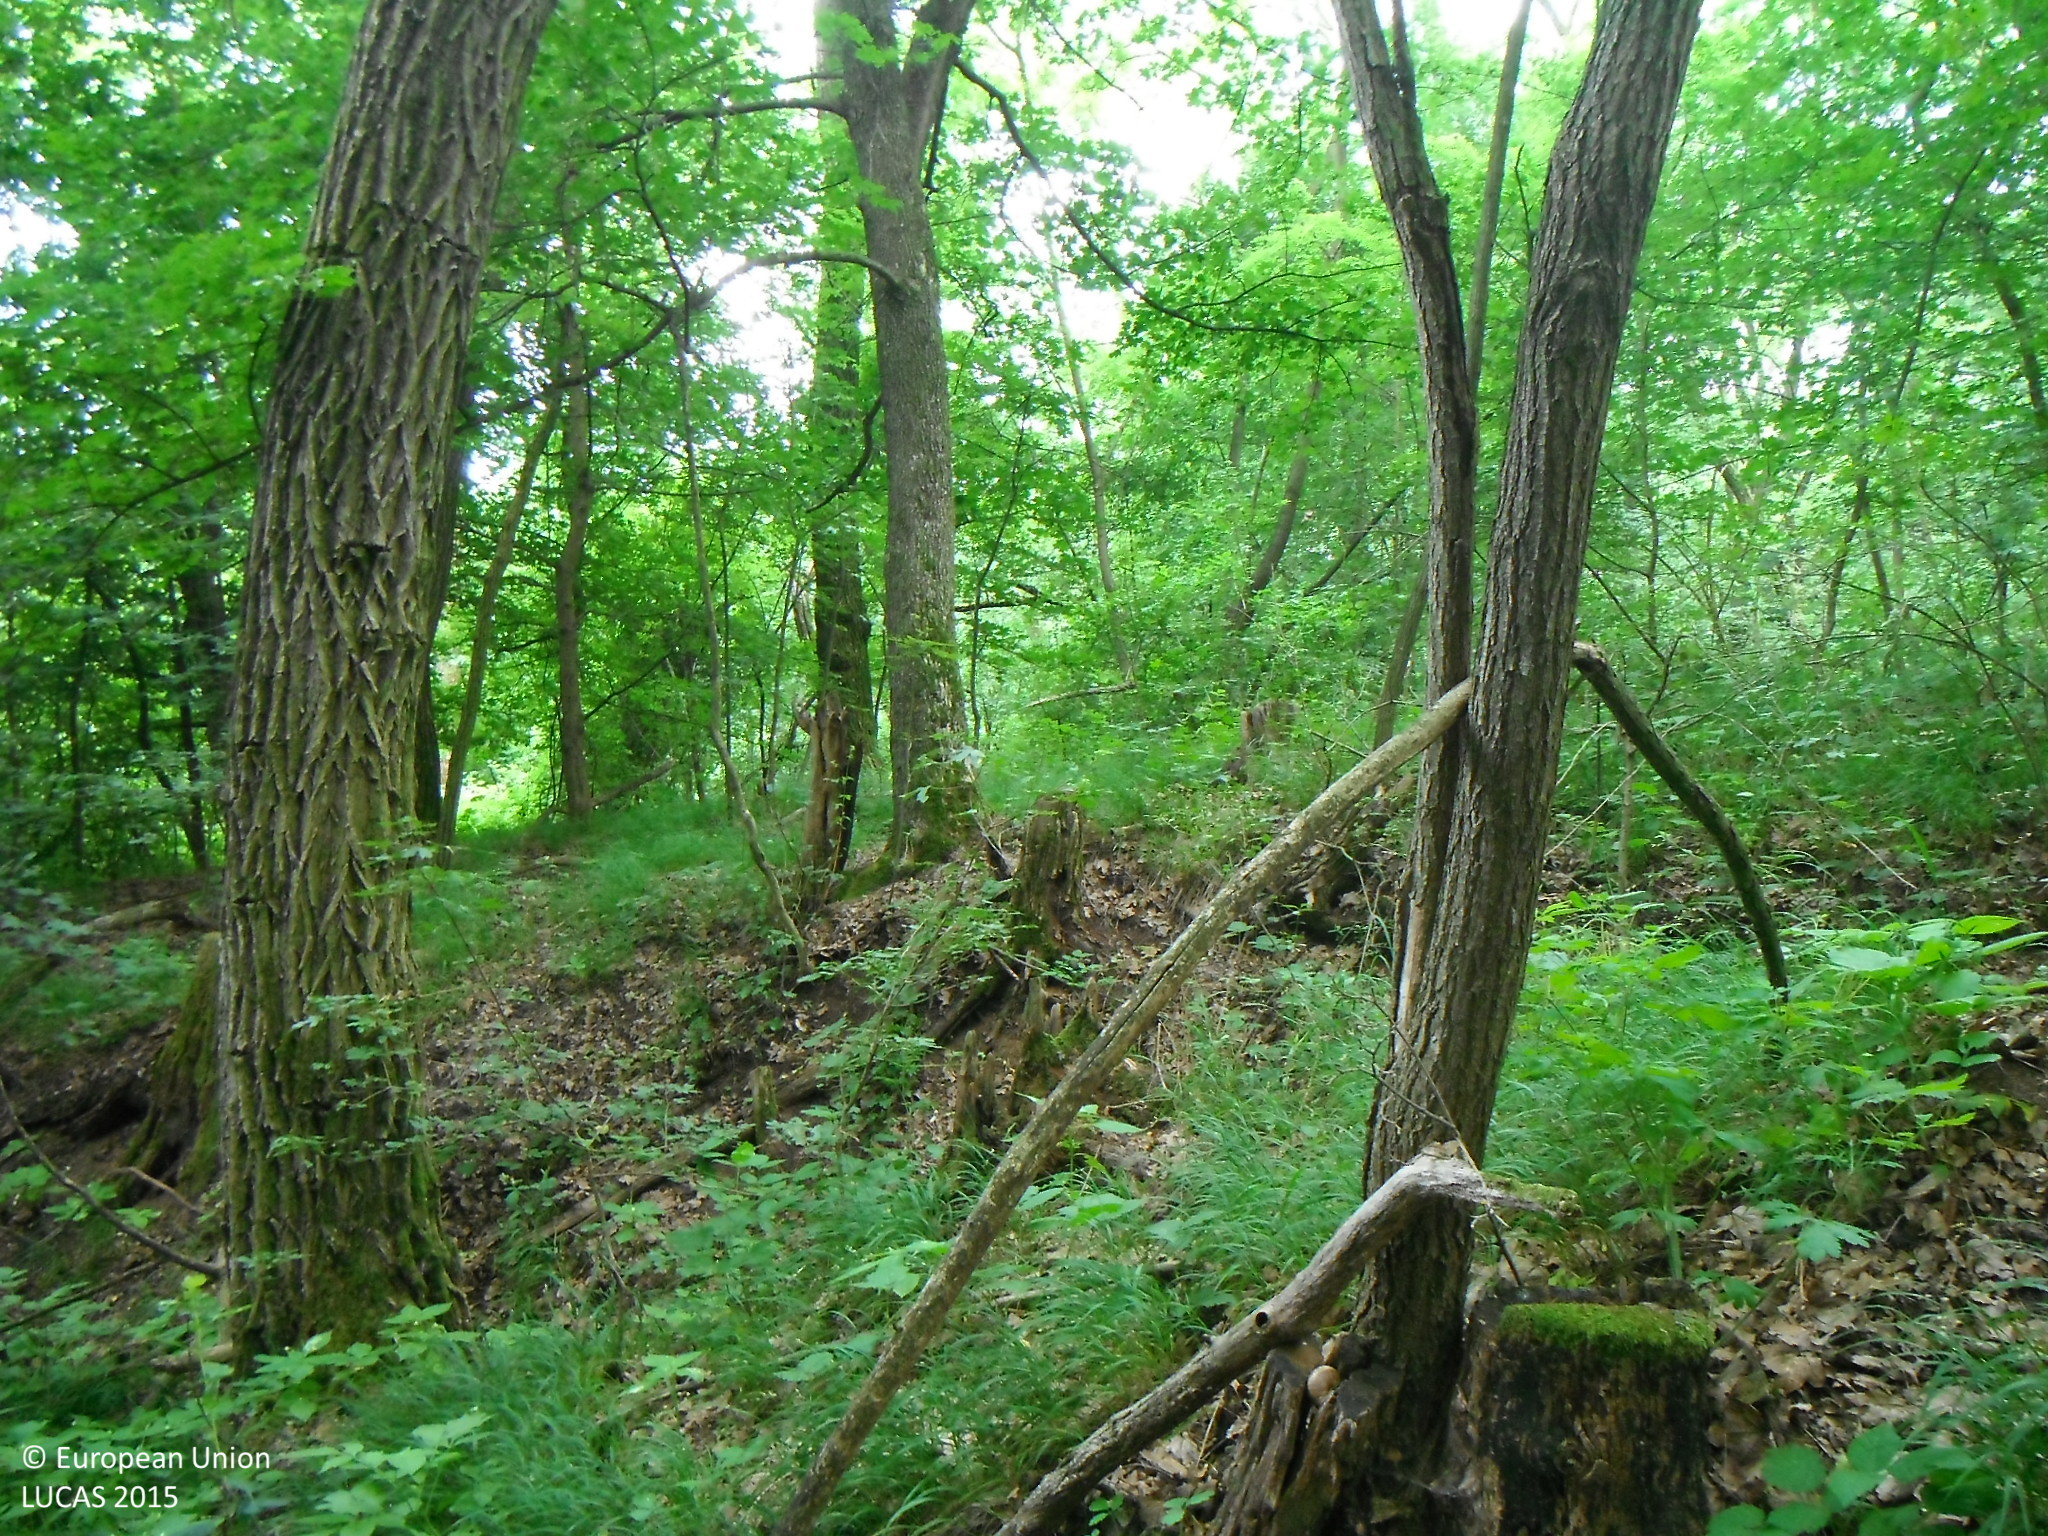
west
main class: Woodland
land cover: Broadleaved woodland
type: mesophytic deciduous forest
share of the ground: > 75 %
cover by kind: broadleaved forest trees 100 %
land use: Forestry
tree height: > 5 m
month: June
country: SK
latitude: 48.2773
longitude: 19.3610
